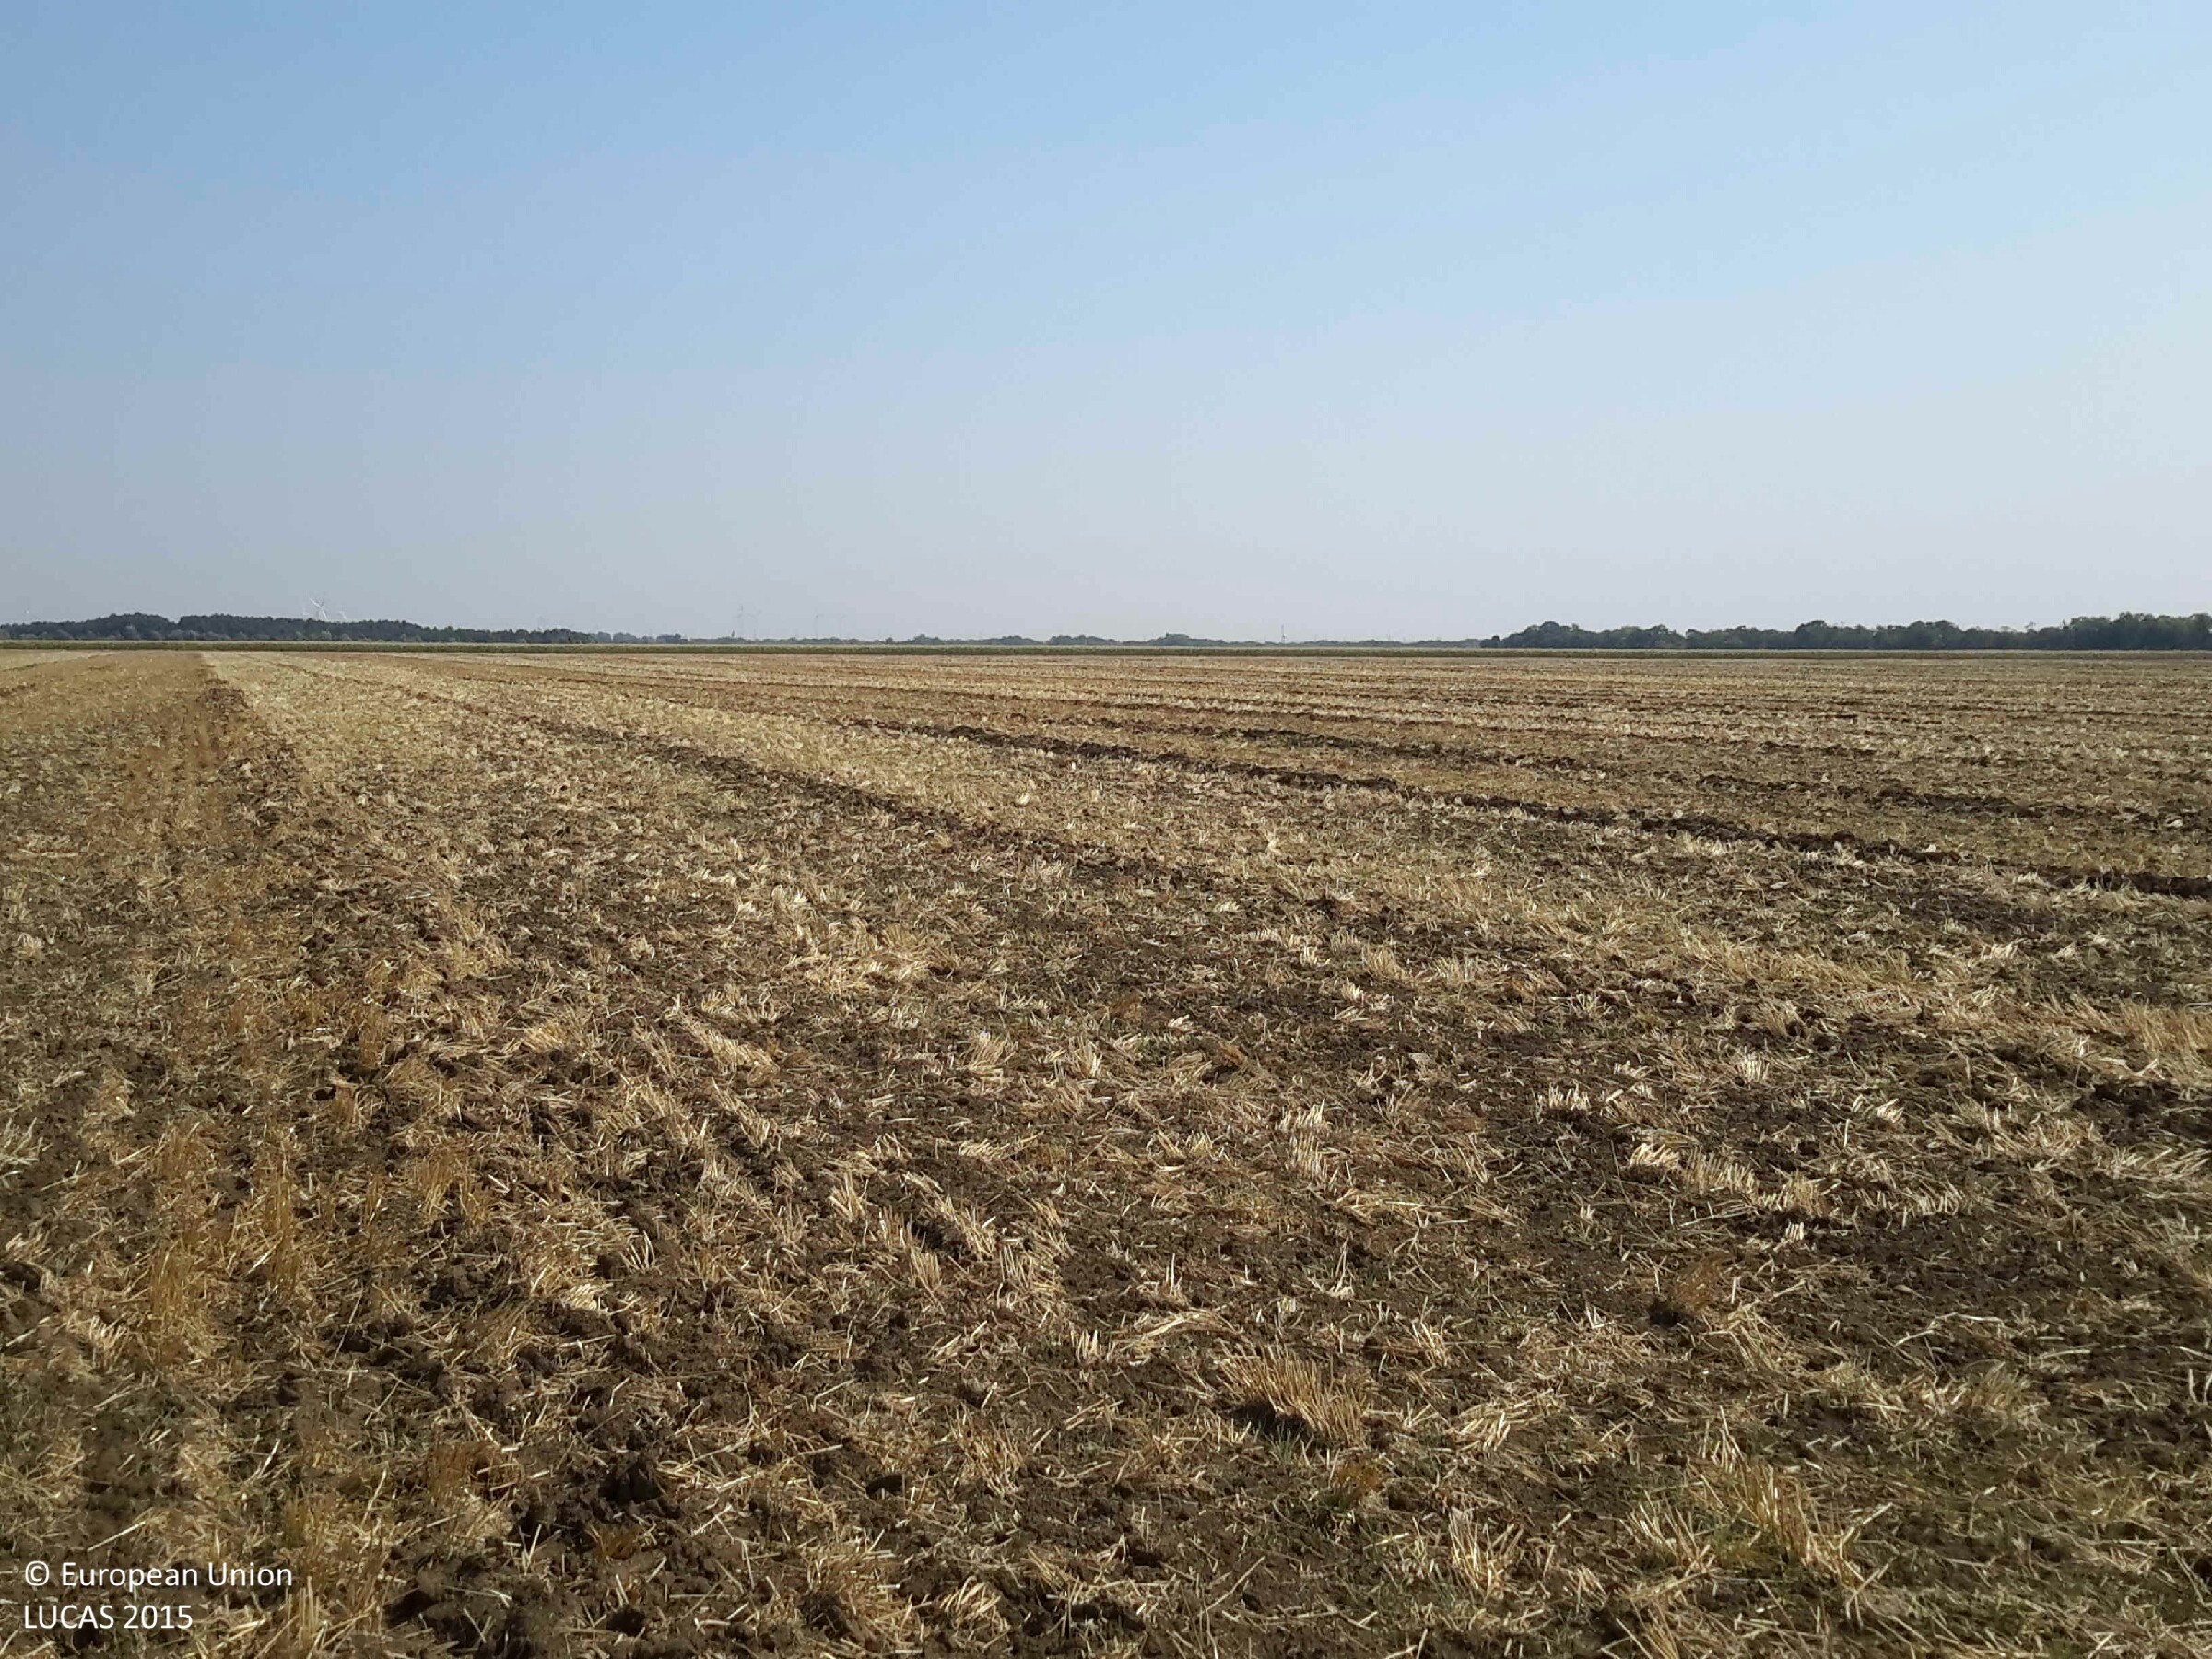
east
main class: Cropland
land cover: Durum wheat
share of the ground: < 10 %
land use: Agriculture (excluding fallow land and kitchen gardens)
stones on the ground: < 10 %
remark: Harvested field
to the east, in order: Durum wheat
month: August
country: HU
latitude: 47.8301
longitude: 17.1275
